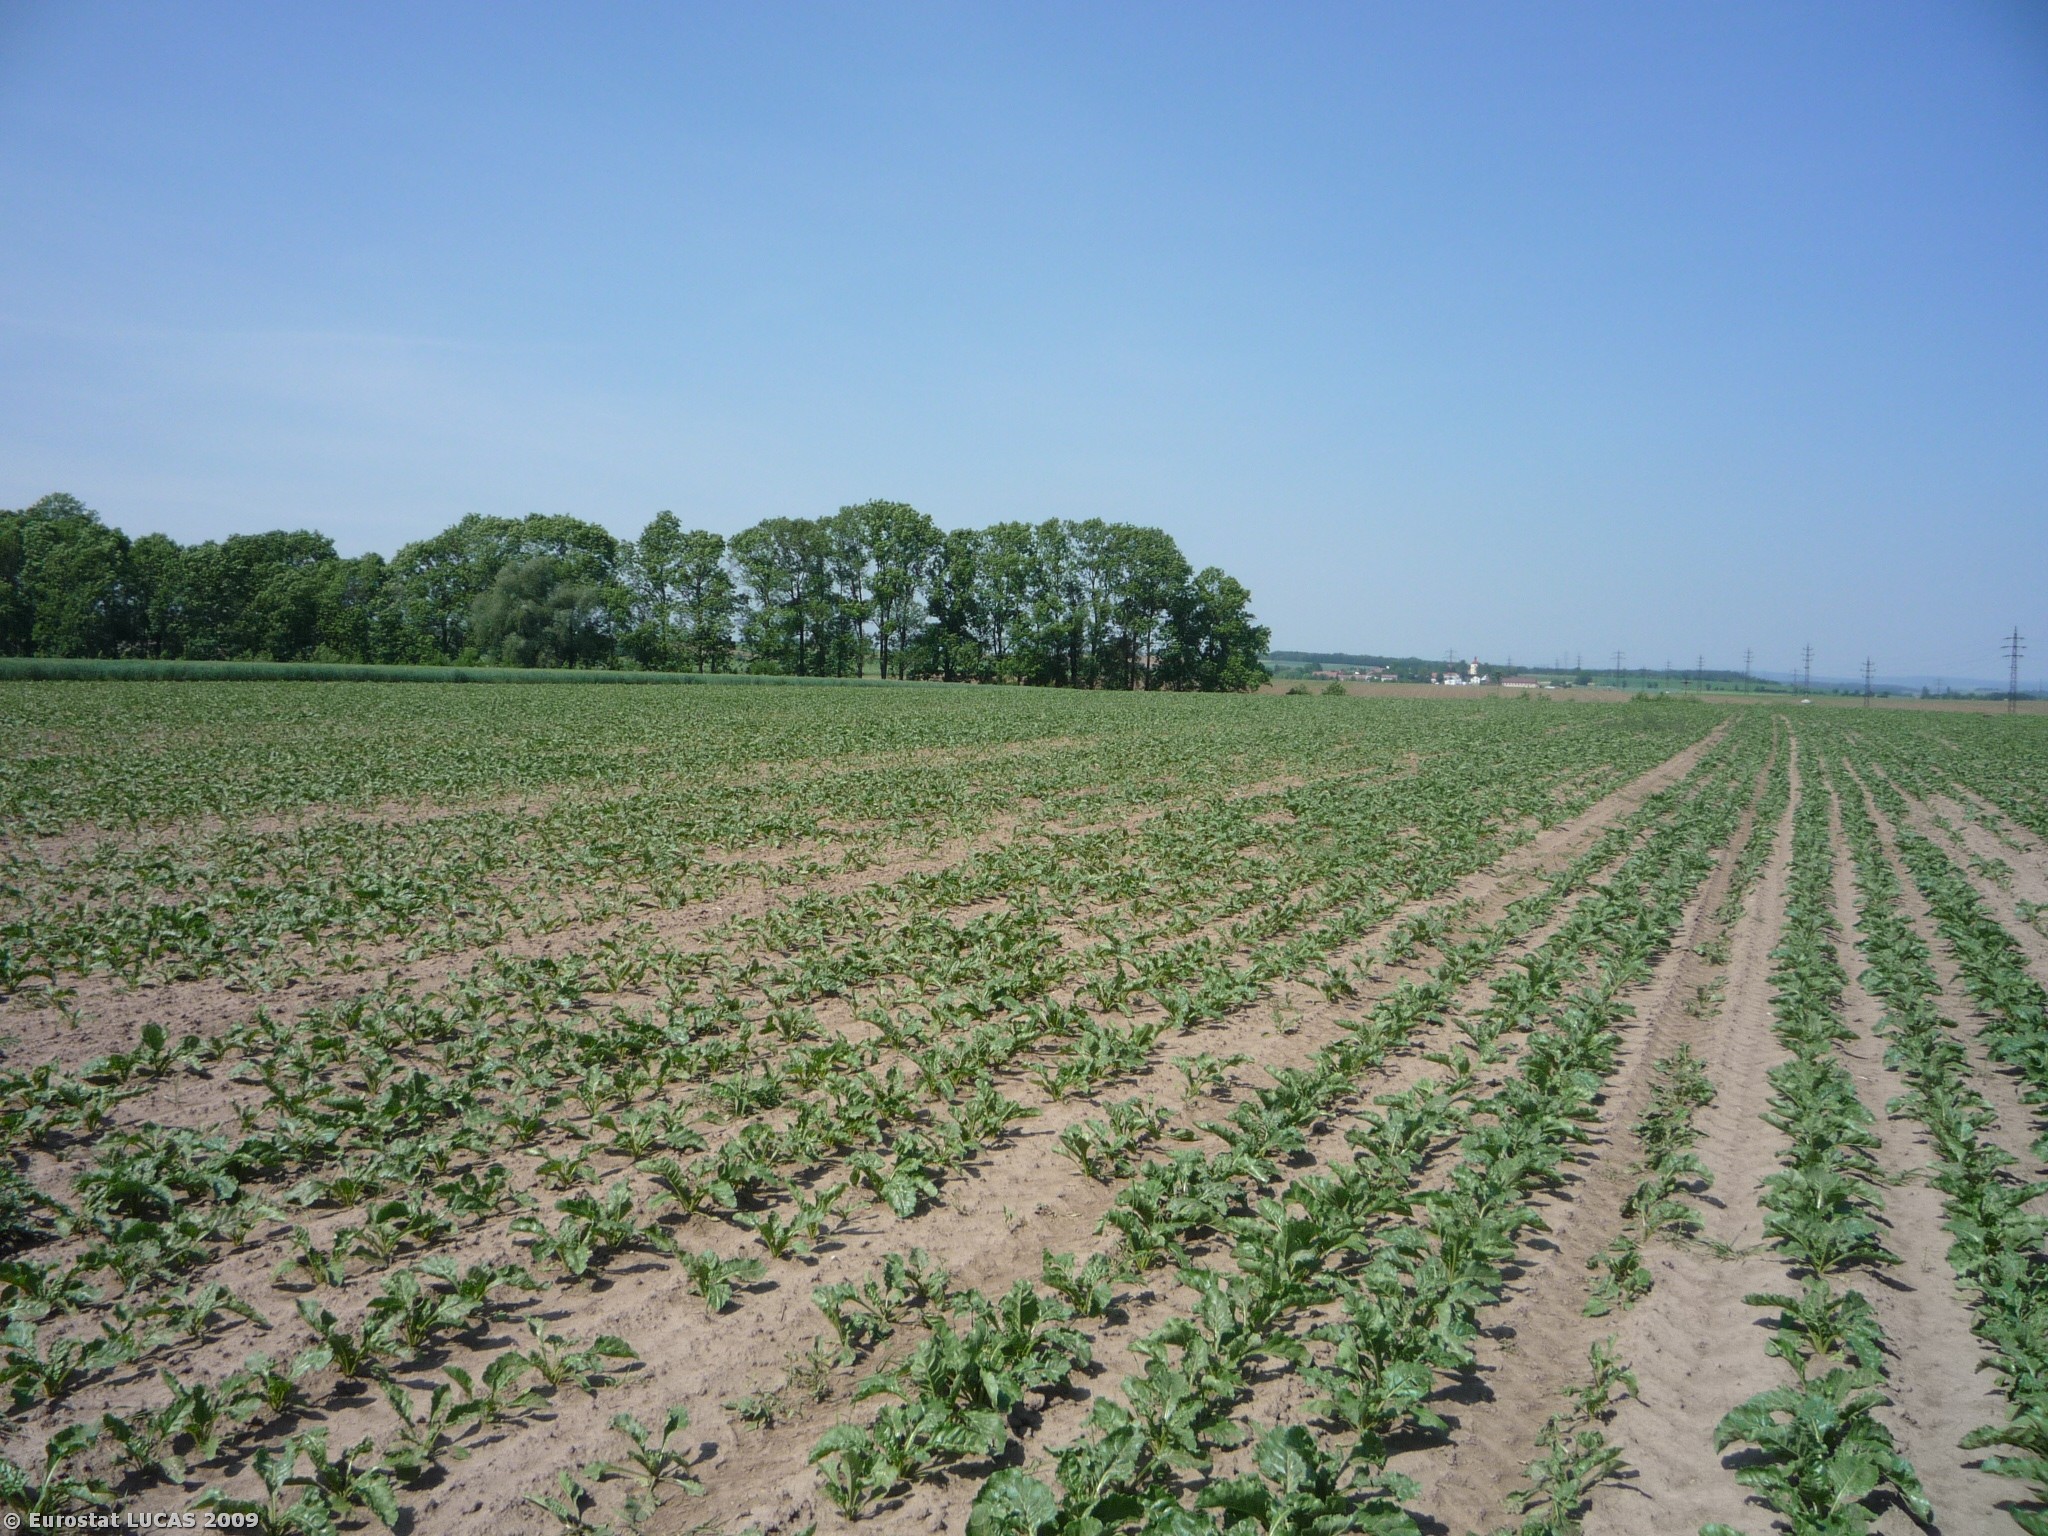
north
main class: Cropland
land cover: Sugar beet
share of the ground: 10 - 25 %
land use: Agriculture (excluding fallow land and kitchen gardens)
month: May
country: CZ
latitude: 50.2710
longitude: 15.7996
